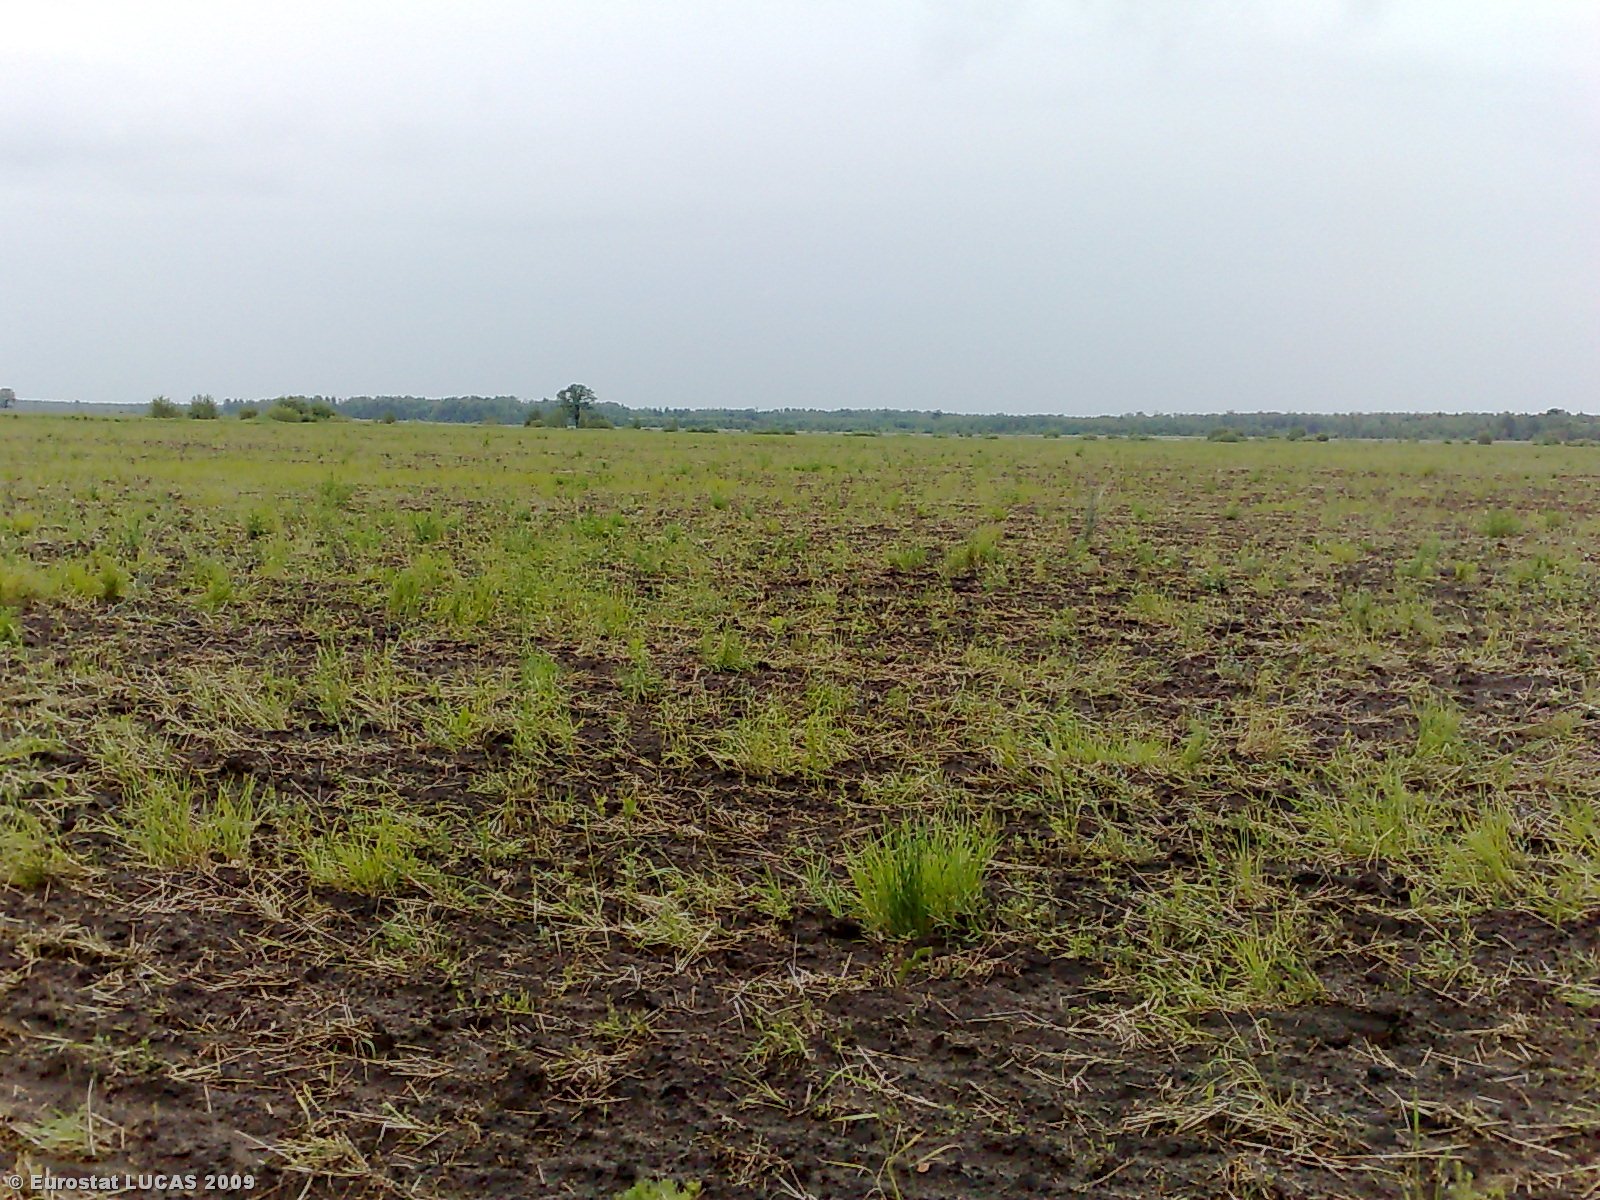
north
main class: Grassland
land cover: Spontaneously vegetated surfaces
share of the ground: 10 - 25 %
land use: Fallow land
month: June
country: LT
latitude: 55.9239
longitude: 24.0270
